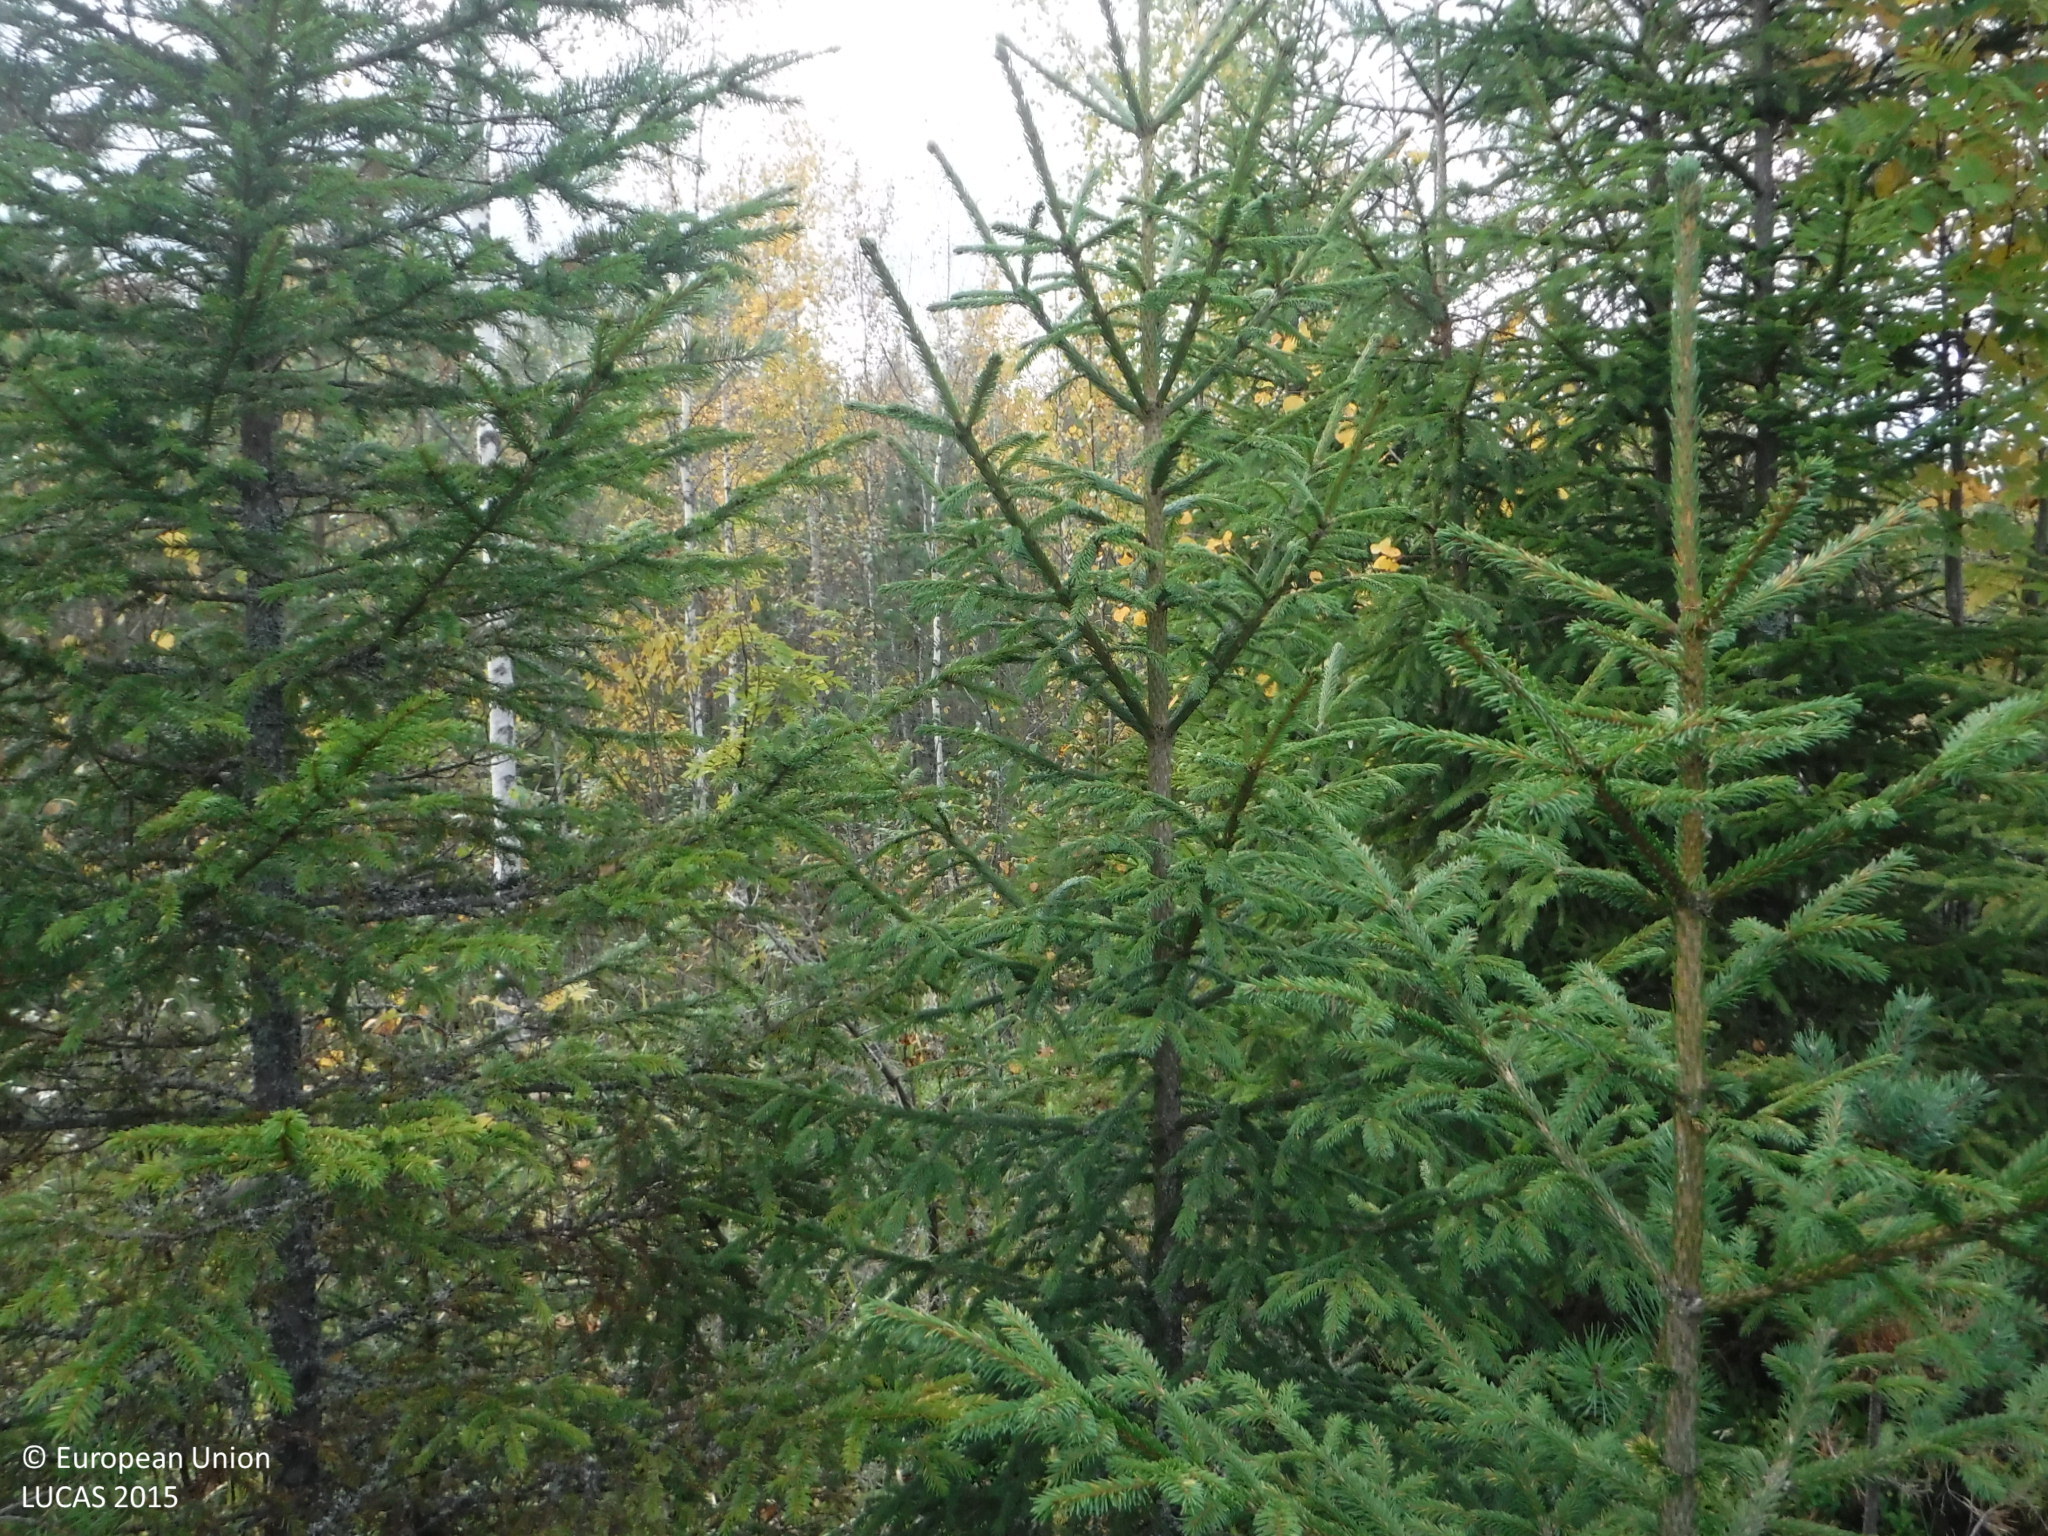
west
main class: Woodland
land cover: Spruce dominated mixed woodland
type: boreal forest
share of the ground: 50 - 75 %
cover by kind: coniferous forest trees 30 %, shrubs 30 %, broadleaved forest trees 20 %, lichens and mosses 20 %
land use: Forestry
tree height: < 5 m
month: September
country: FI
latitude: 62.1305
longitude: 23.2828
